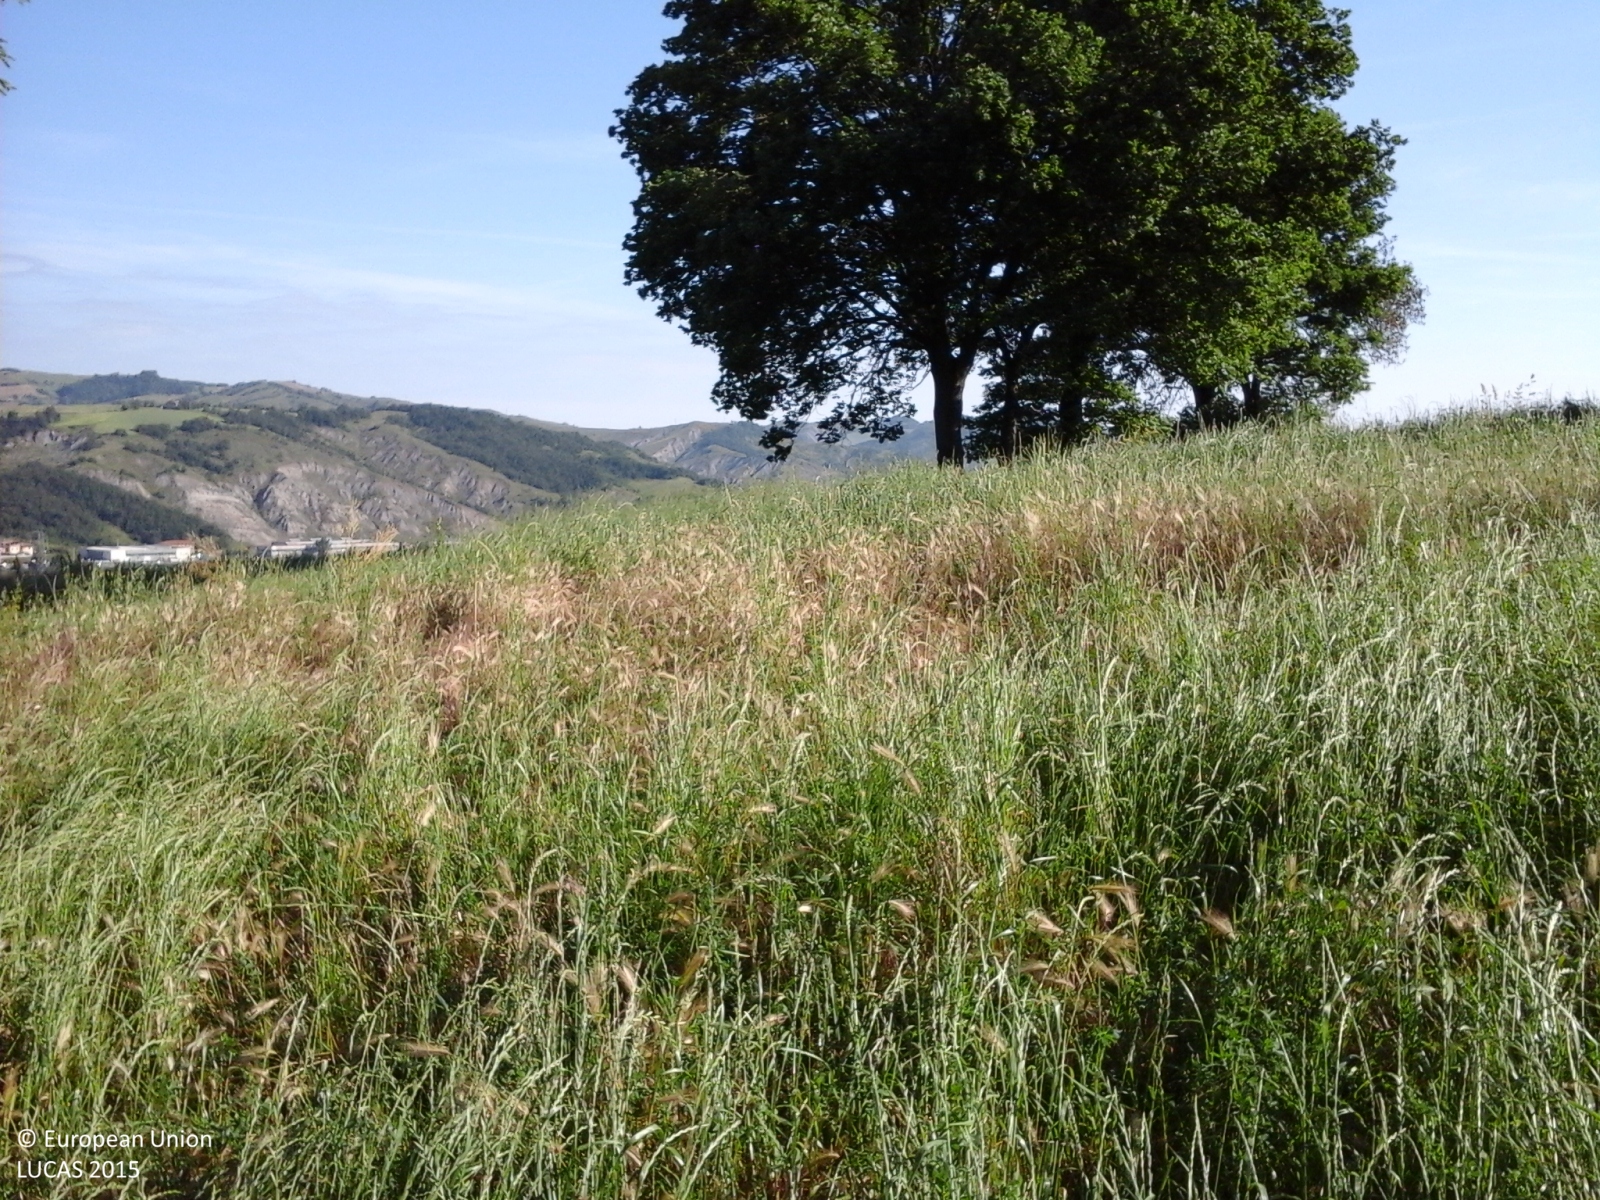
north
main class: Cropland
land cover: Lucerne
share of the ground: > 75 %
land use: Agriculture (excluding fallow land and kitchen gardens)
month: May
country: IT
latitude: 44.4566
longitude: 10.6646
